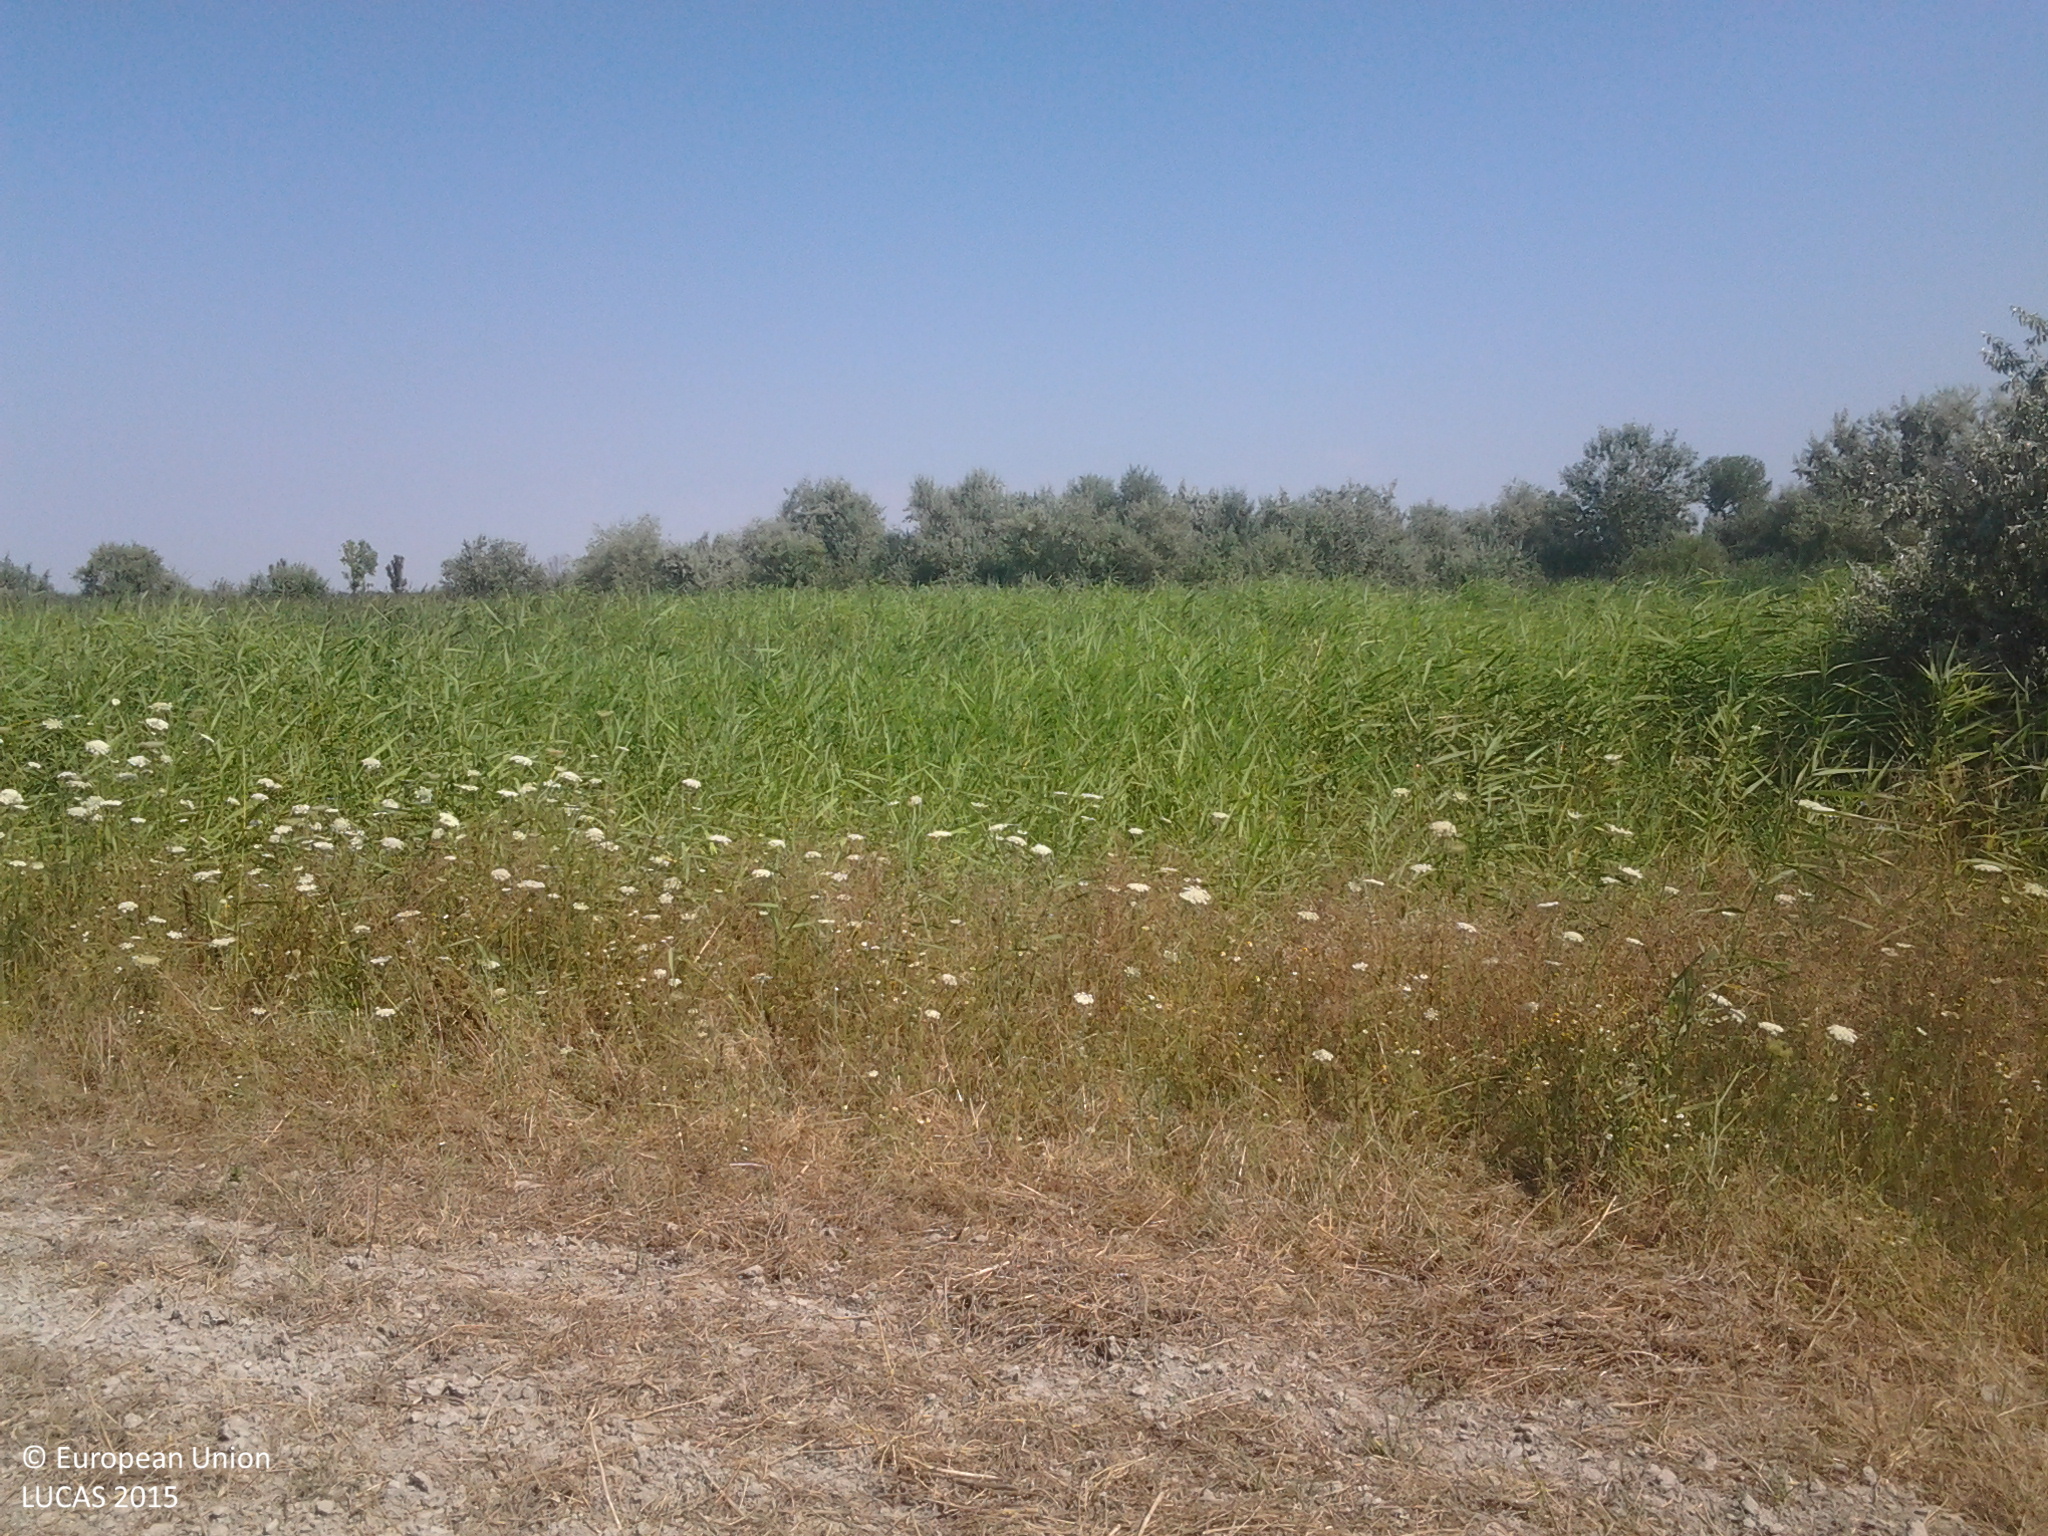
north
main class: Cropland
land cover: Rape and turnip rape
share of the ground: < 10 %
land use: Agriculture (excluding fallow land and kitchen gardens)
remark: Harvested field
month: July
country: HU
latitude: 46.6715
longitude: 19.0733
